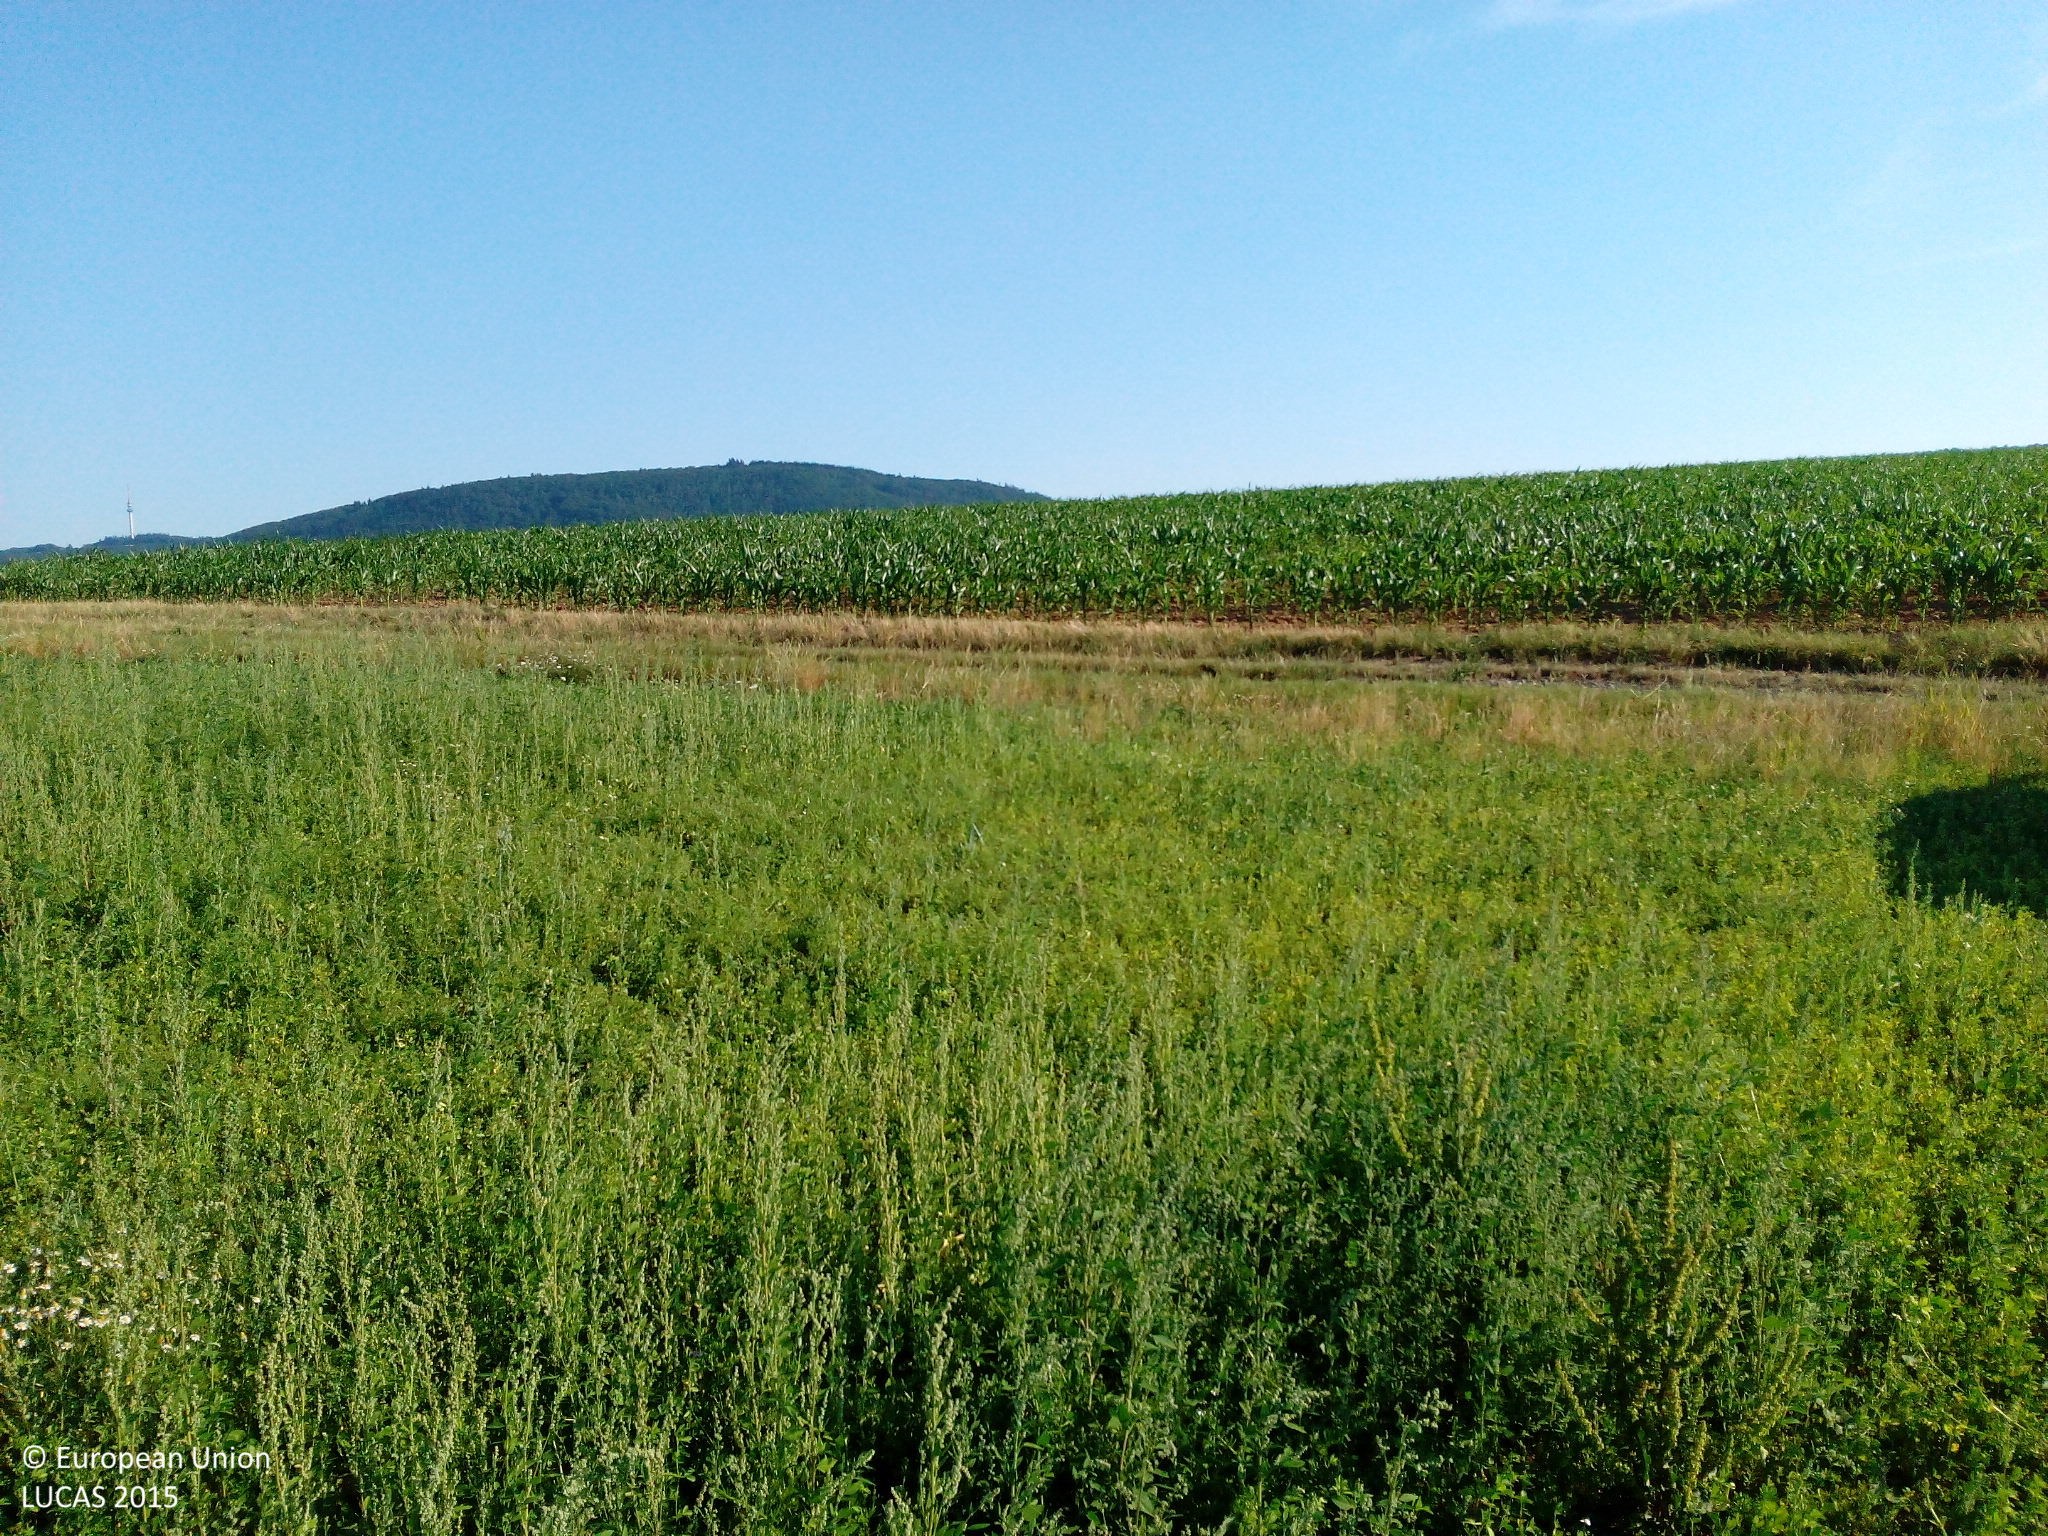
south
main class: Cropland
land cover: Clovers
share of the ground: > 75 %
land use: Agriculture (excluding fallow land and kitchen gardens)
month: July
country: DE
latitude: 49.5996
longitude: 7.5237
